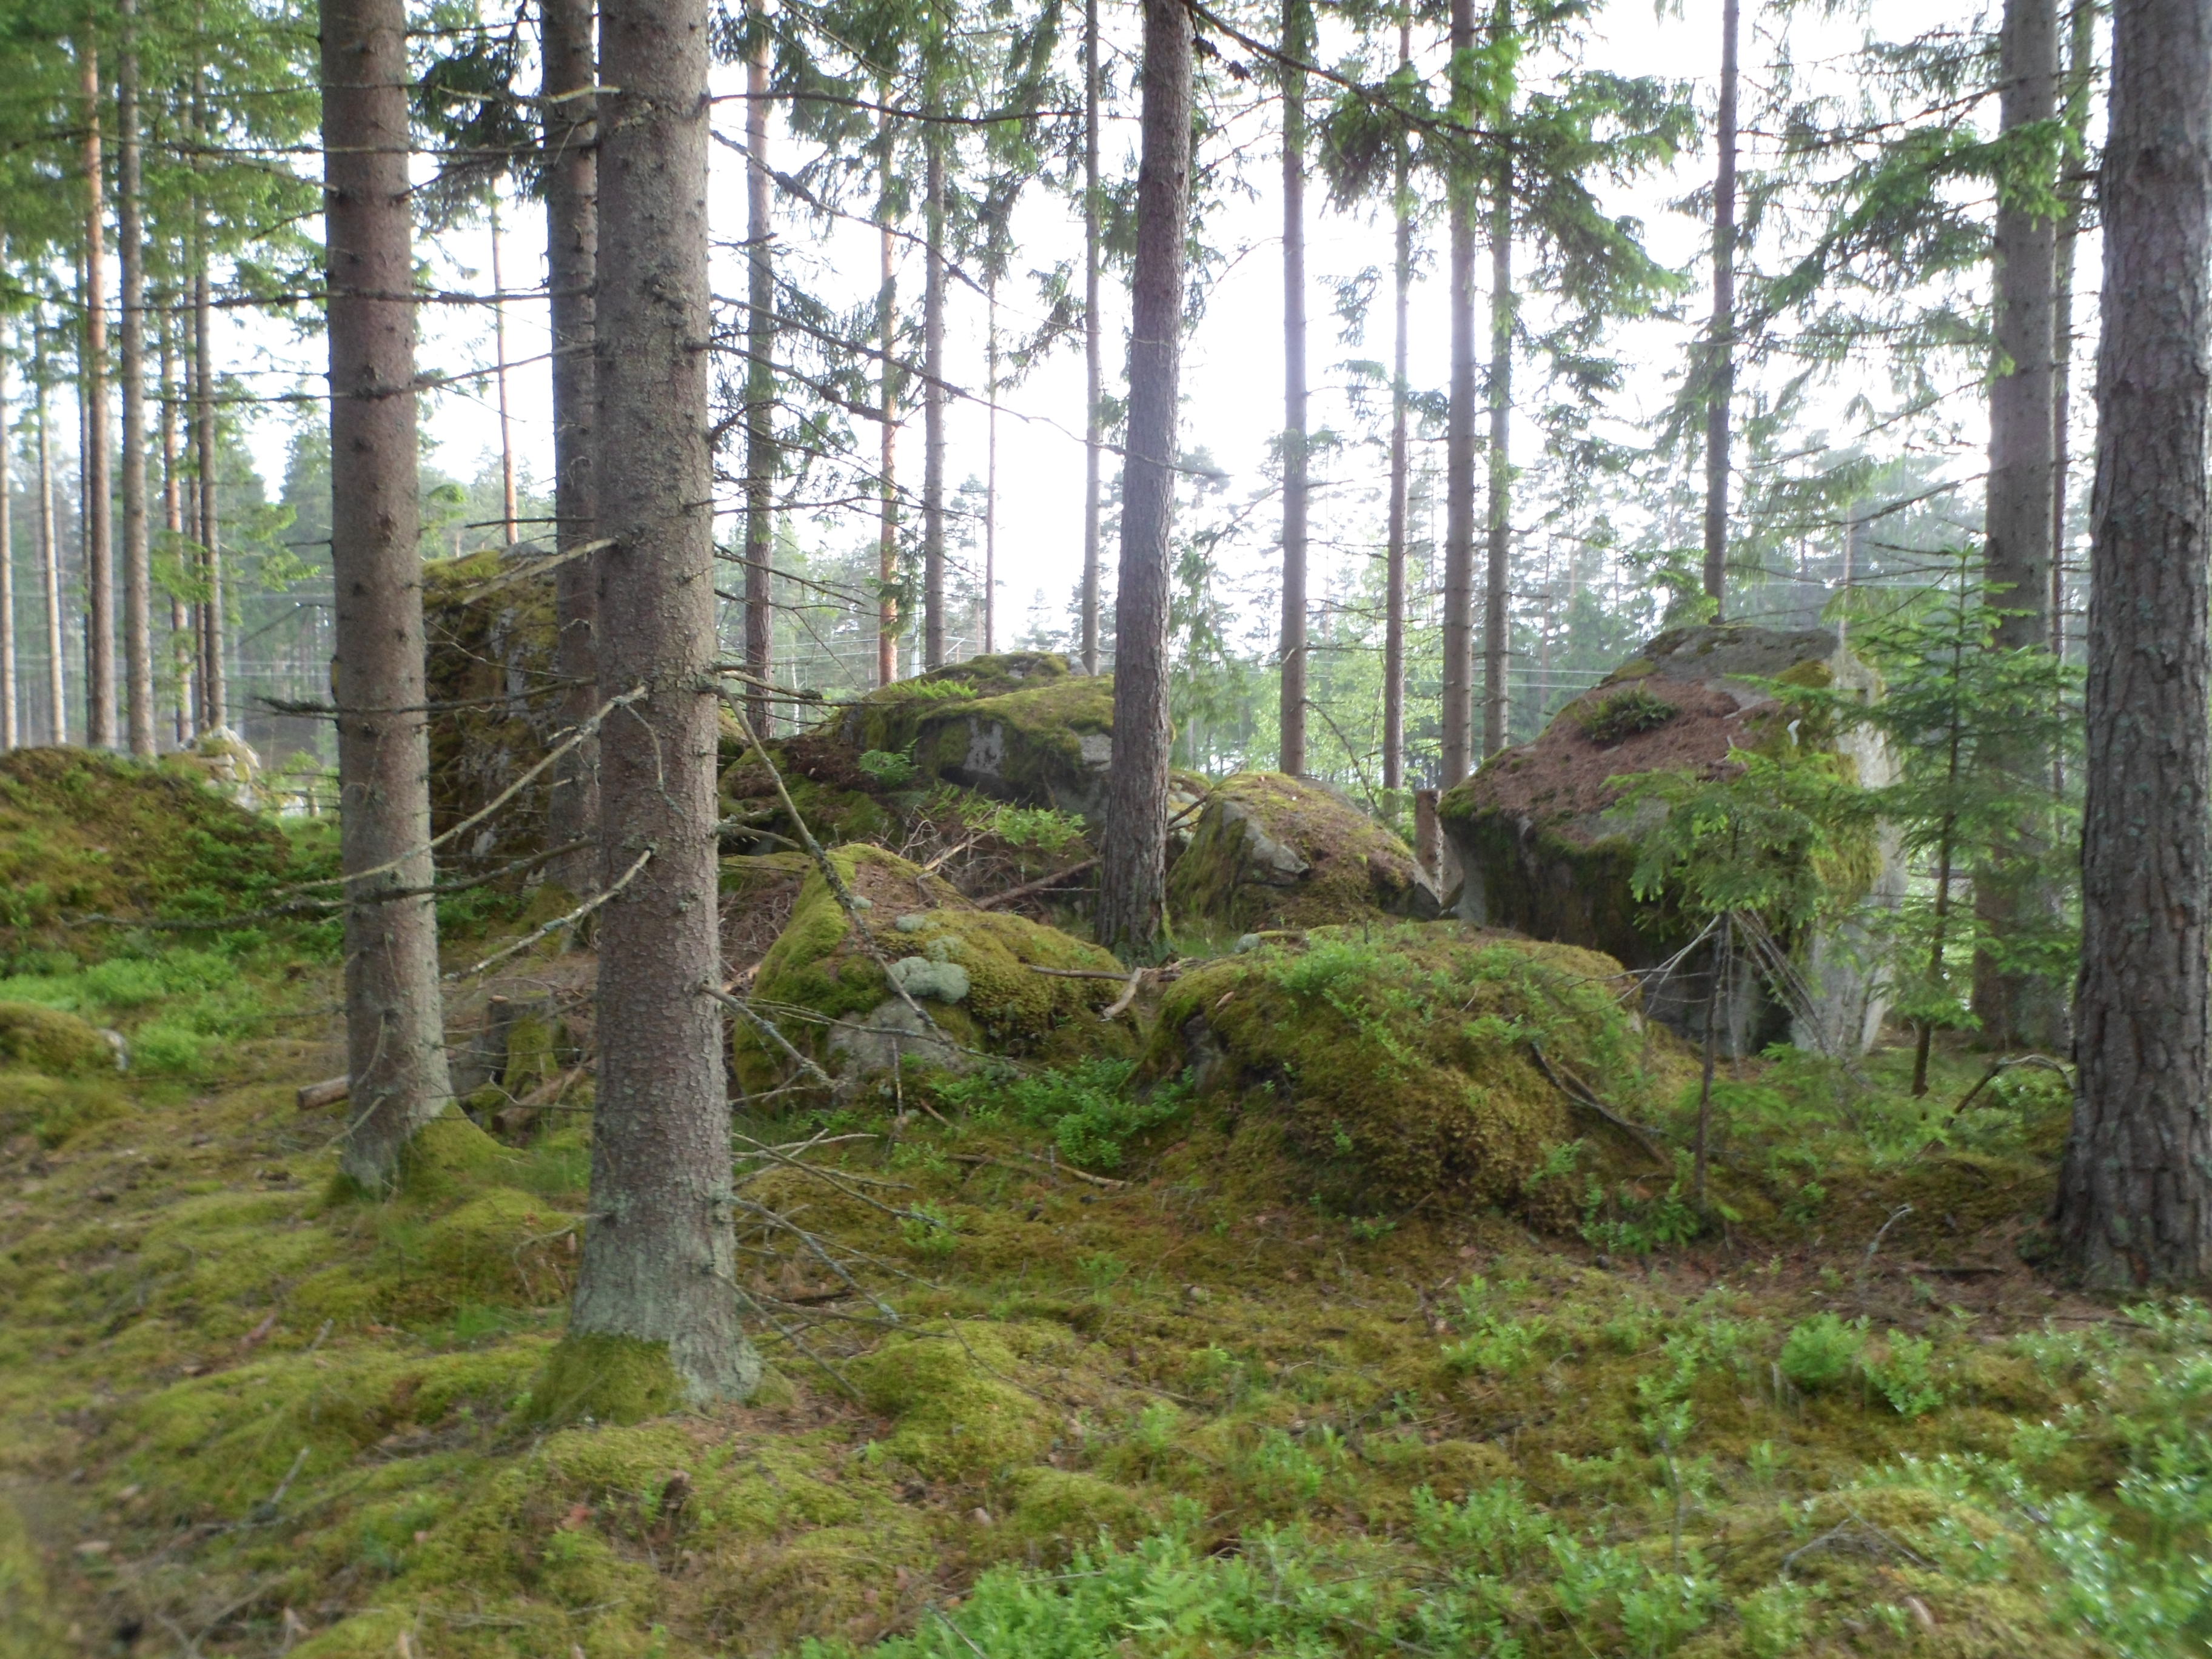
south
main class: Woodland
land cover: Spruce dominated coniferous woodland
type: boreal forest
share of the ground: 50 - 75 %
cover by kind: coniferous forest trees 55 %, shrubs 25 %, lichens and mosses 10 %, broadleaved forest trees 5 %, herbaceous plants 5 %
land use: Forestry
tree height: > 5 m
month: June
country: SE
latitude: 56.8795
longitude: 14.6080
